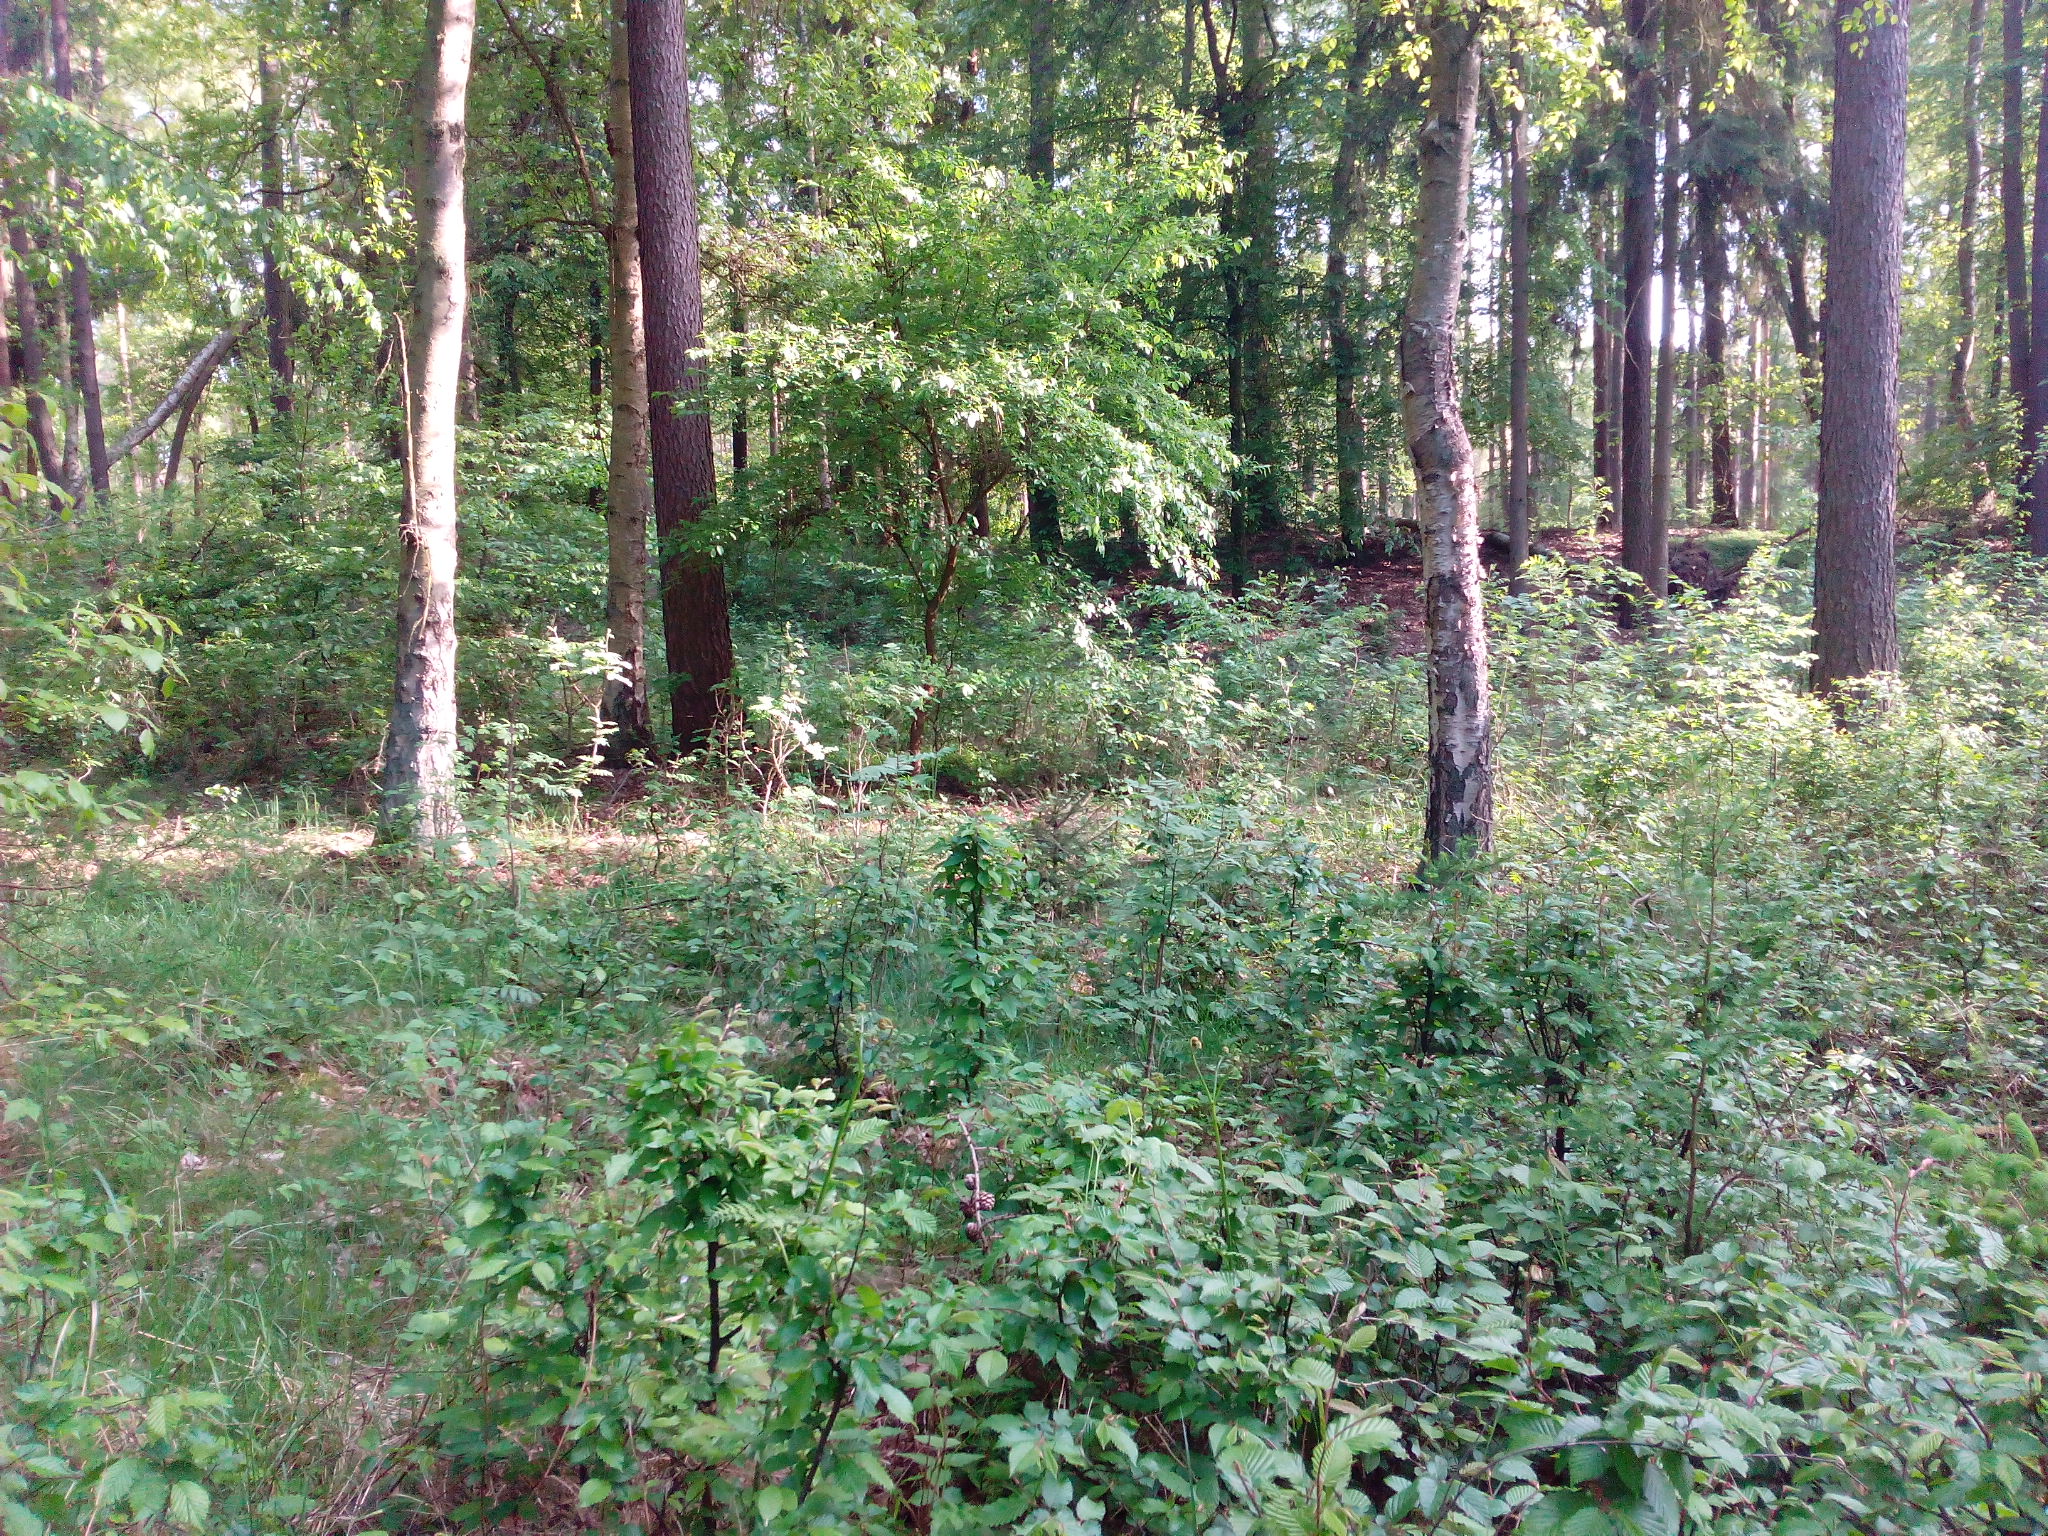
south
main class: Woodland
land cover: Other mixed woodland
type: hemiboreal forest and nemoral coniferous forest and mixed broadleaved-coniferous forest
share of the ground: 25 - 50 %
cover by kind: coniferous forest trees 30 %, broadleaved forest trees 25 %, herbaceous plants 25 %, lichens and mosses 20 %
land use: Forestry
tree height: > 5 m
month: May
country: DE
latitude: 52.9360
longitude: 13.5561
